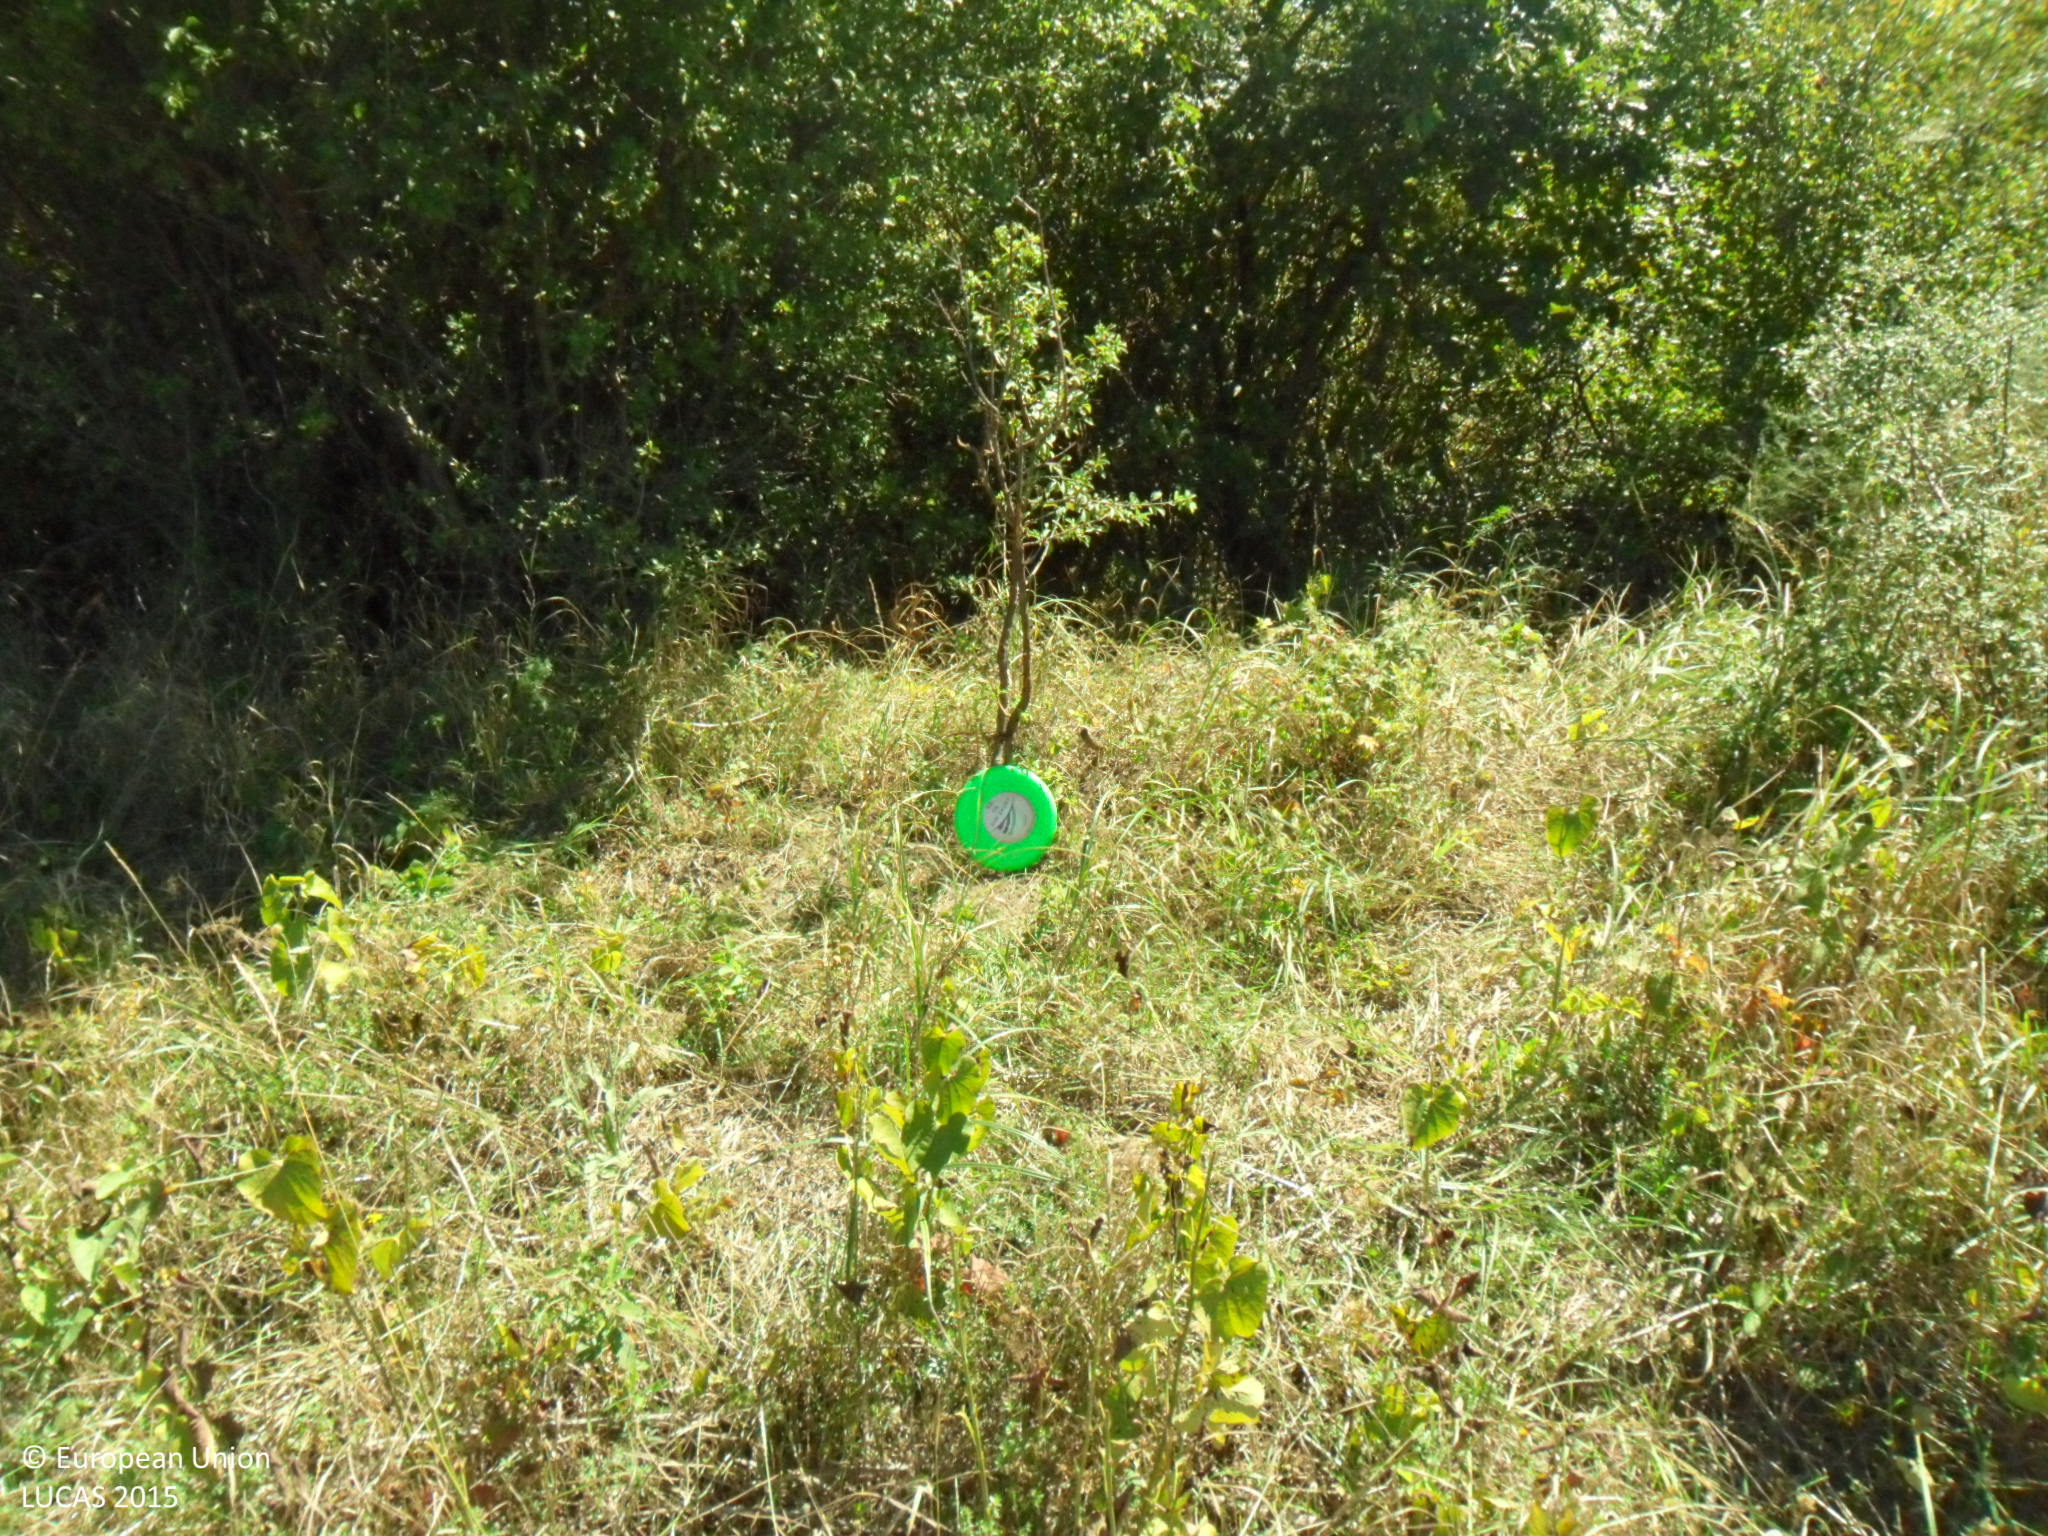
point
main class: Woodland
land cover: Broadleaved woodland
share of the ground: > 75 %
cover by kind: broadleaved forest trees 70 %, shrubs 25 %, herbaceous plants 5 %
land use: Semi-natural and natural areas not in use
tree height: > 5 m
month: September
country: BG
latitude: 43.2629
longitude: 26.8021
